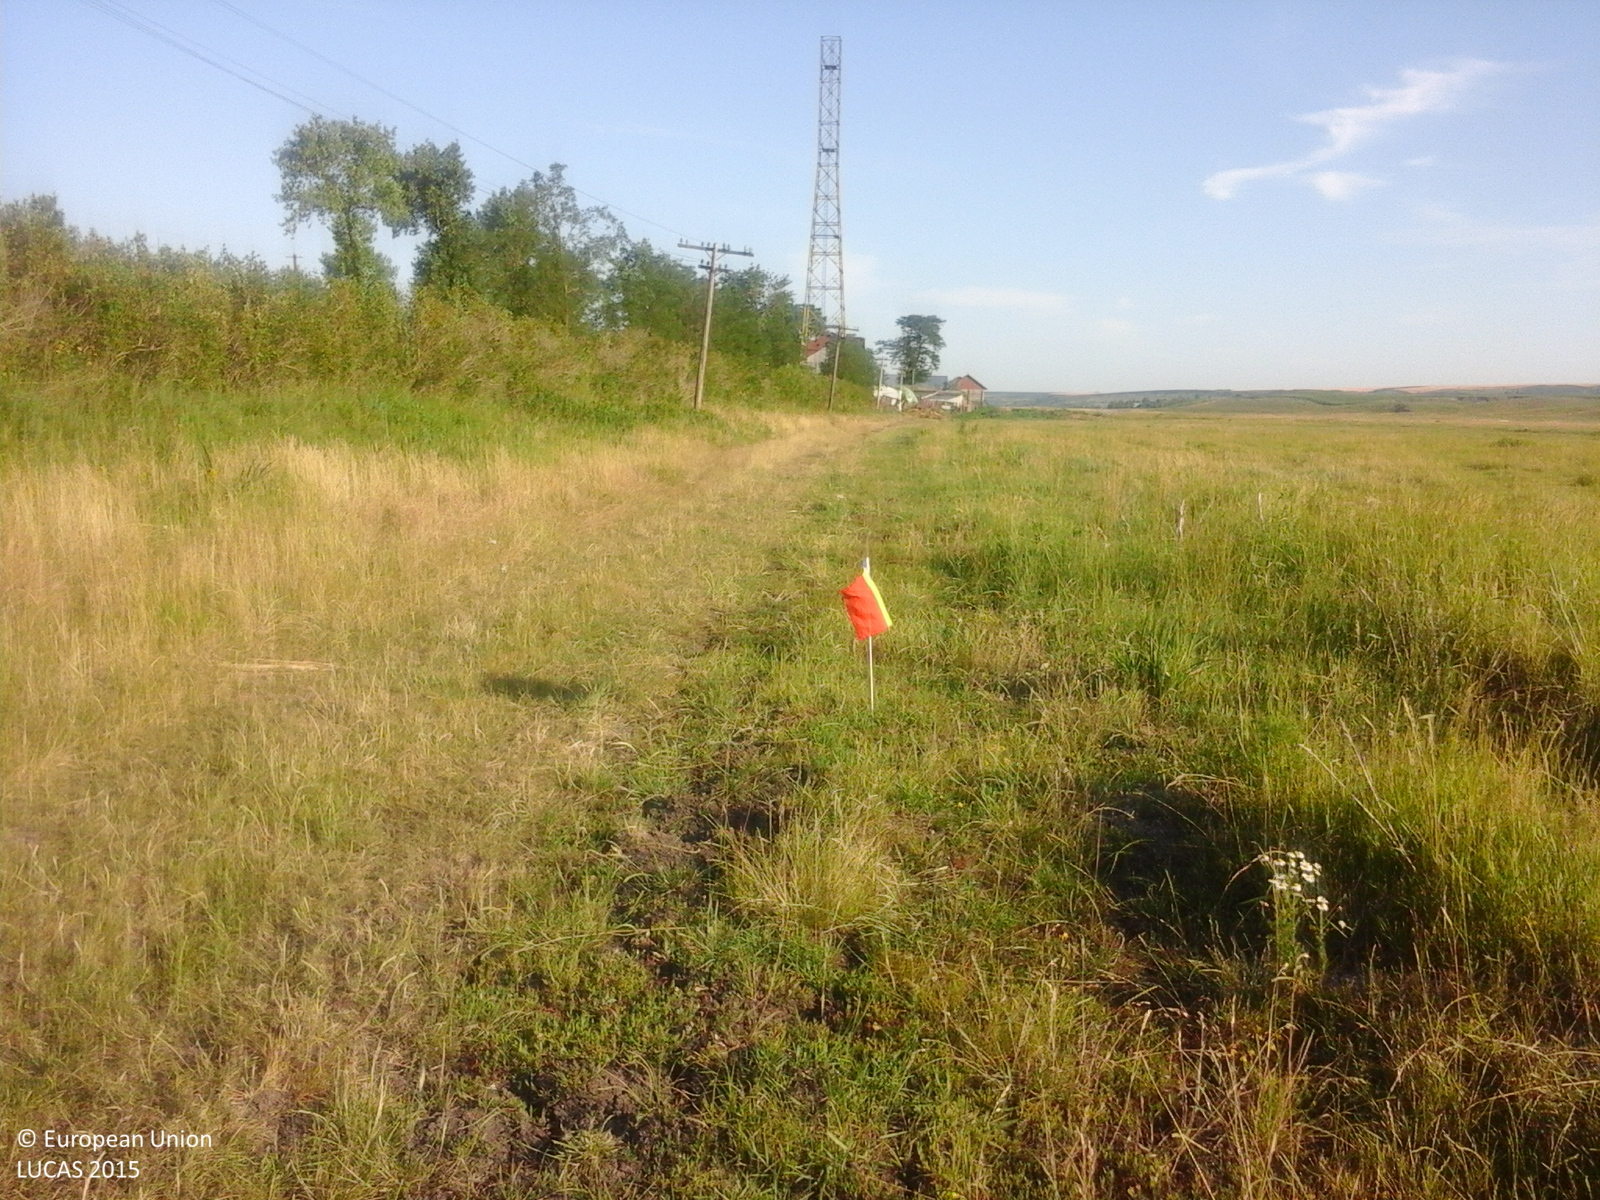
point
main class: Grassland
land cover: Grassland without tree/shrub cover
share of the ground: > 75 %
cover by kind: herbaceous plants 100 %
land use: Agriculture (excluding fallow land and kitchen gardens)
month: June
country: RO
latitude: 47.4859
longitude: 27.2988
